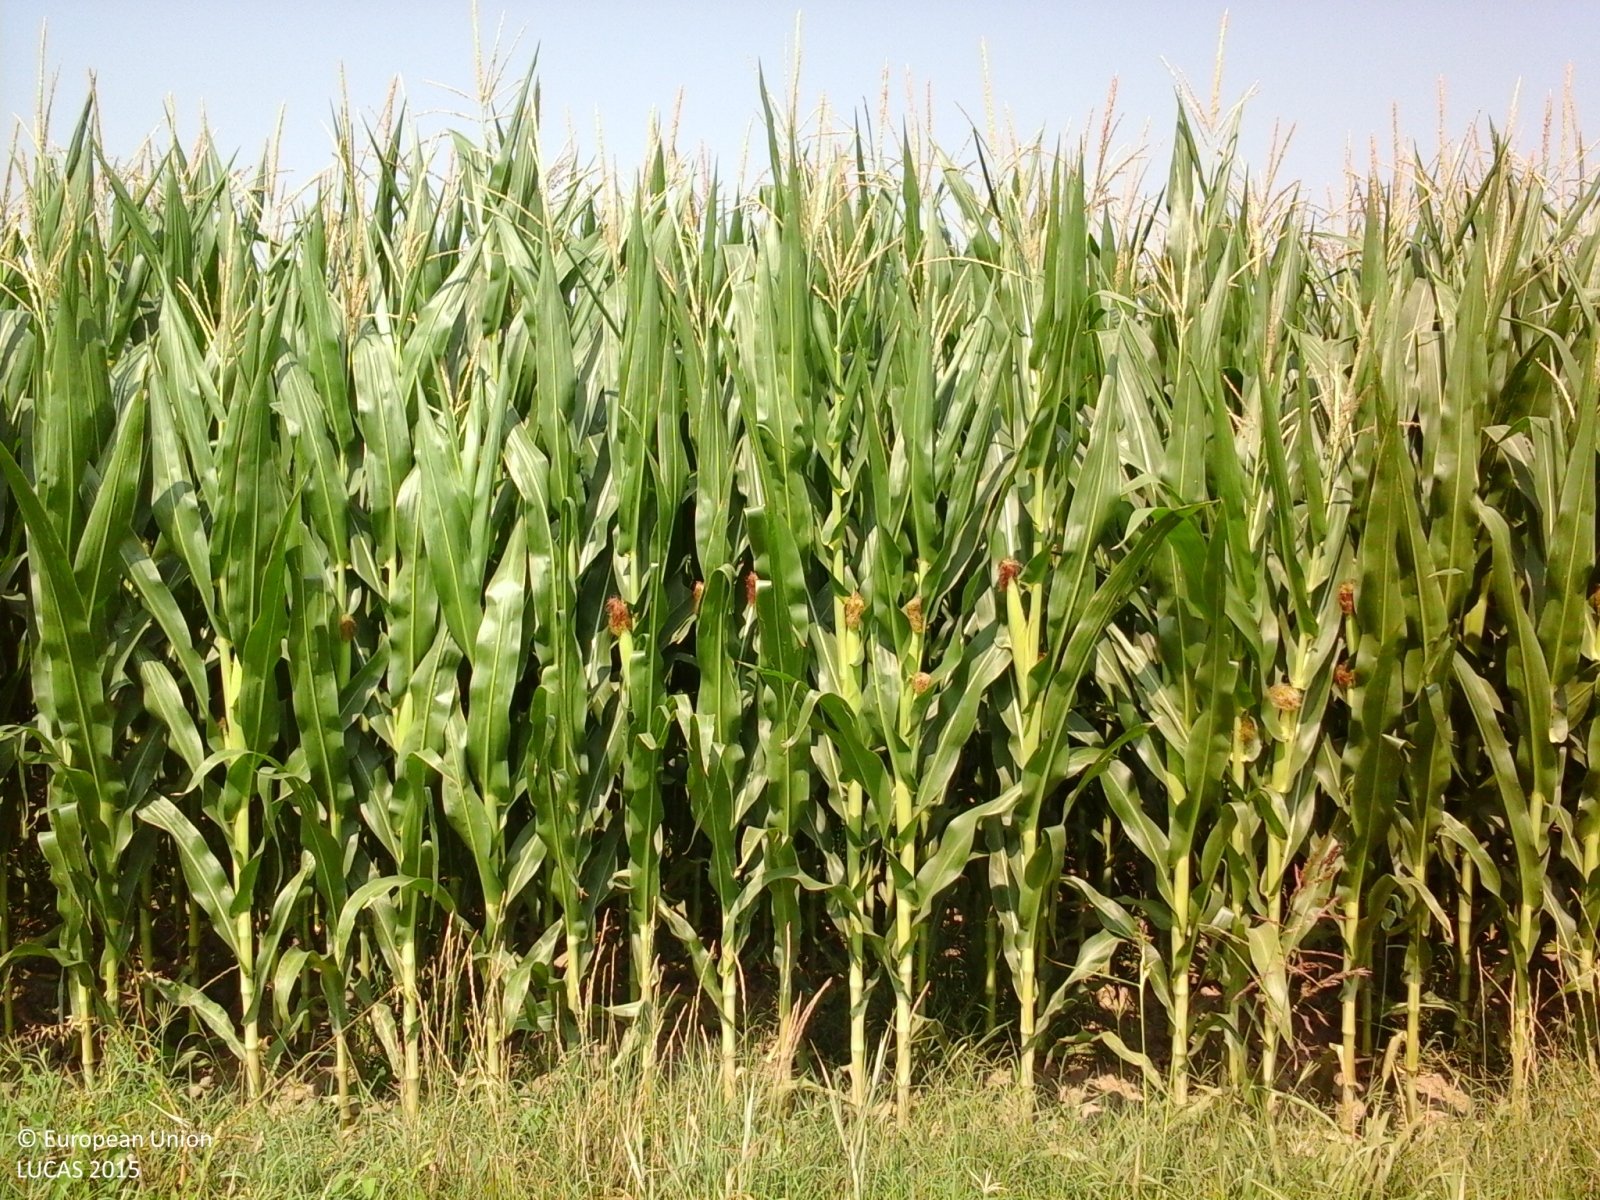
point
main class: Cropland
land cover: Maize
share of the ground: > 75 %
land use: Agriculture (excluding fallow land and kitchen gardens)
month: July
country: IT
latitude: 44.5900
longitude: 11.6467
